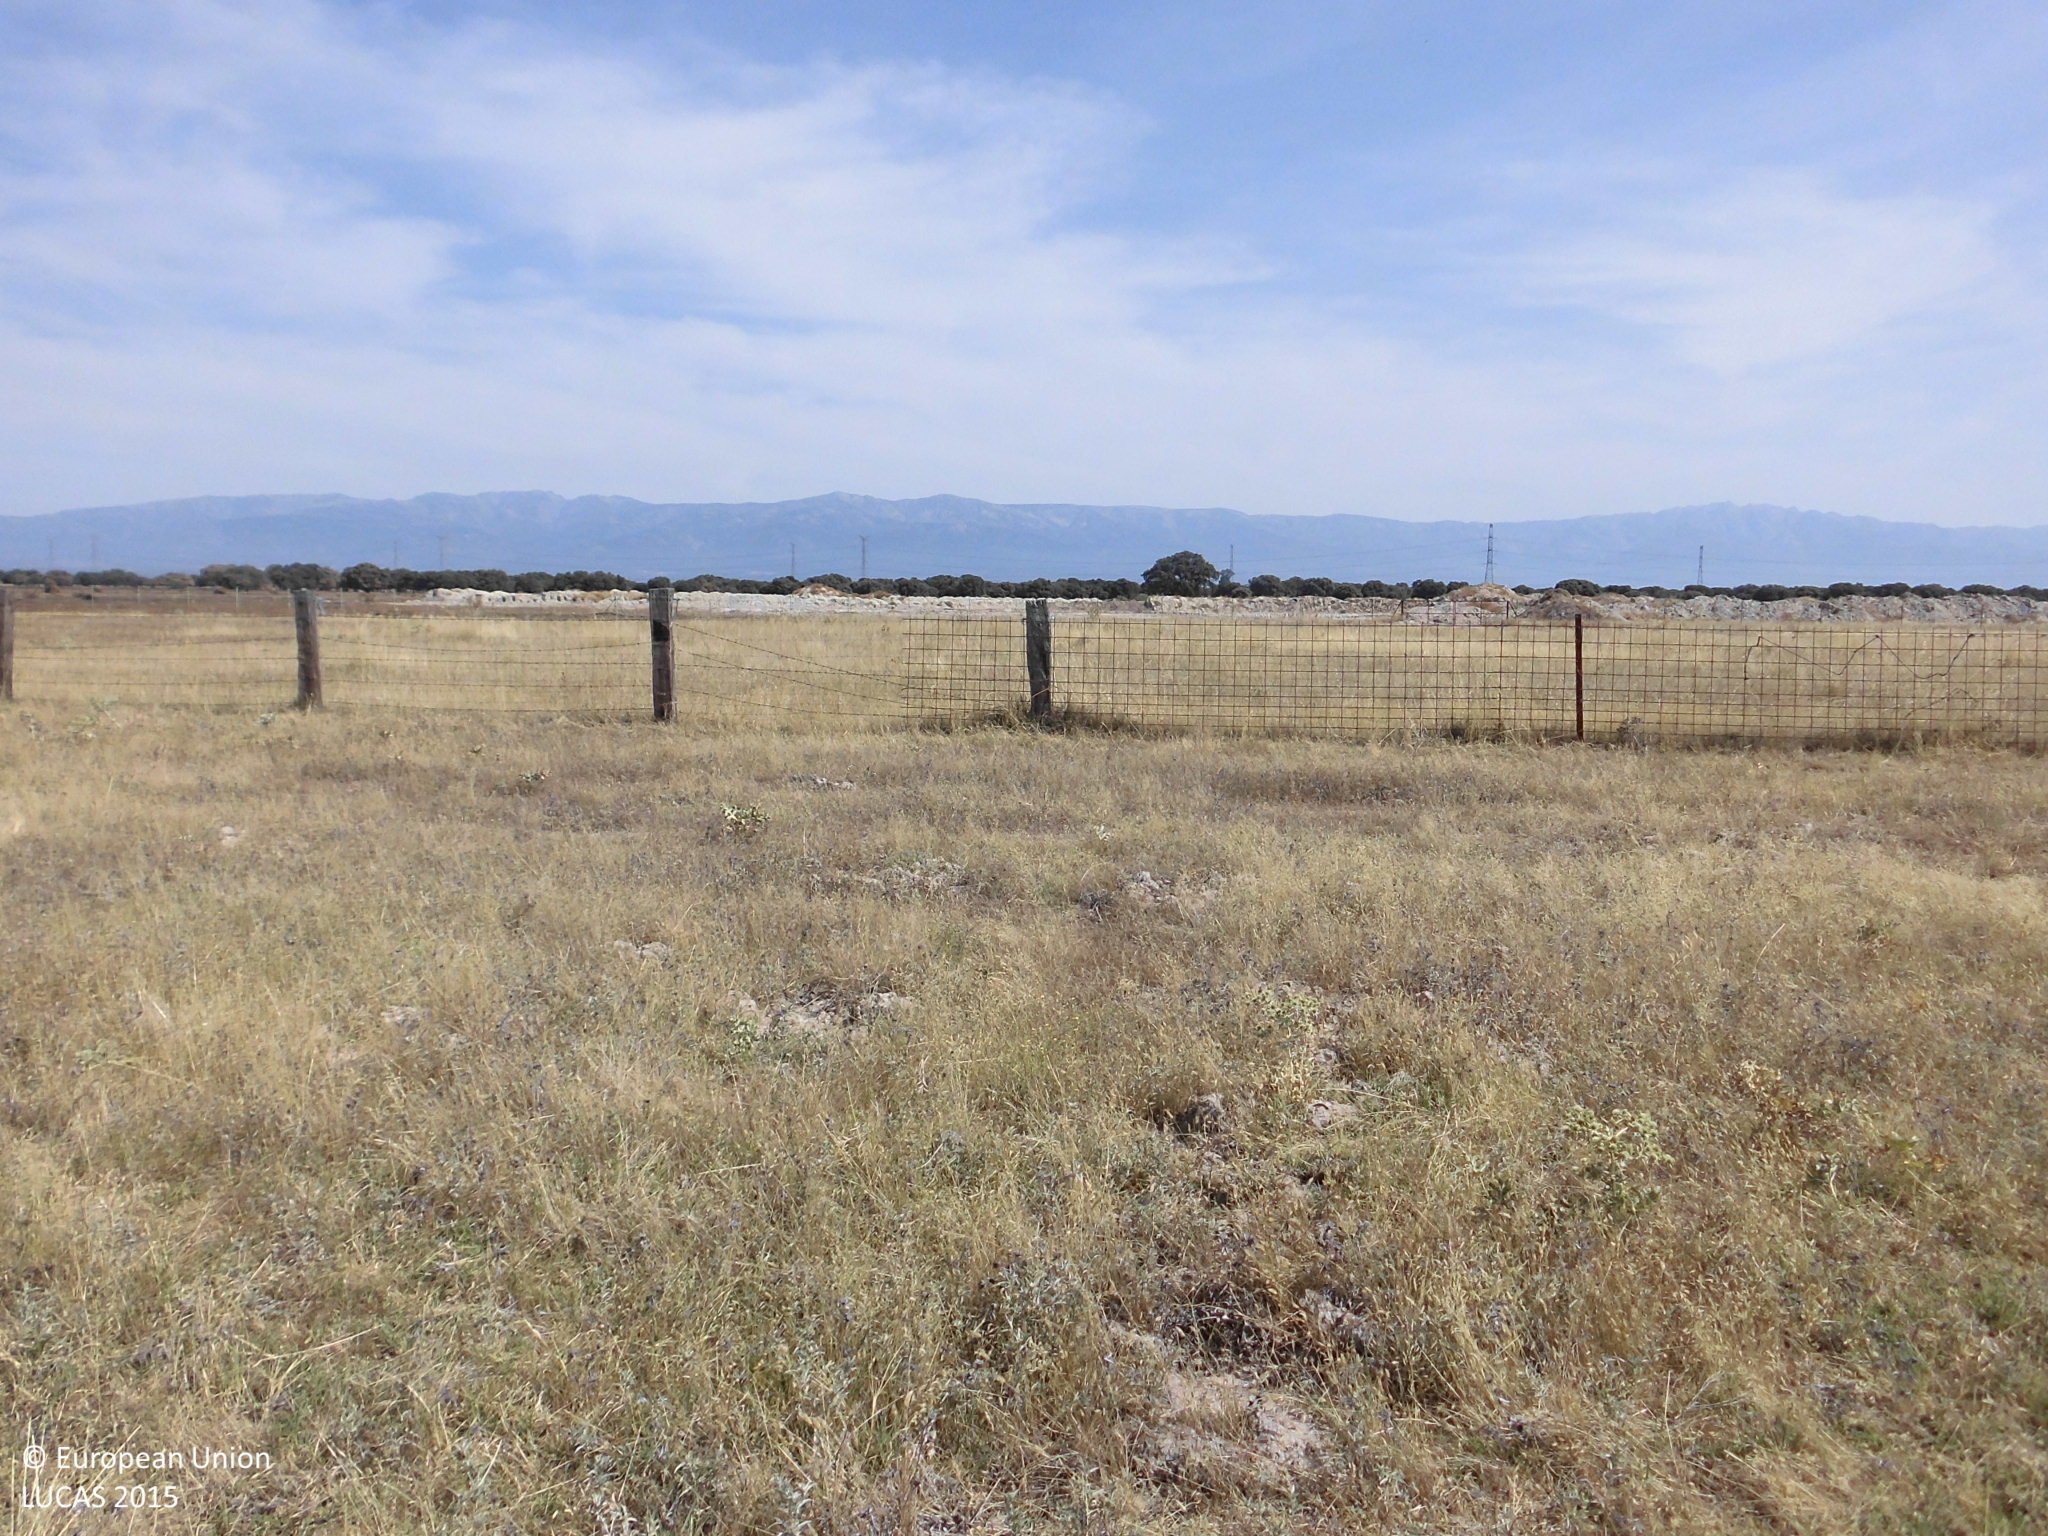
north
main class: Grassland
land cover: Grassland without tree/shrub cover
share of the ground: > 75 %
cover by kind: herbaceous plants 100 %
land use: Agriculture (excluding fallow land and kitchen gardens)
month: July
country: ES
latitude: 39.9151
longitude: -5.4652
